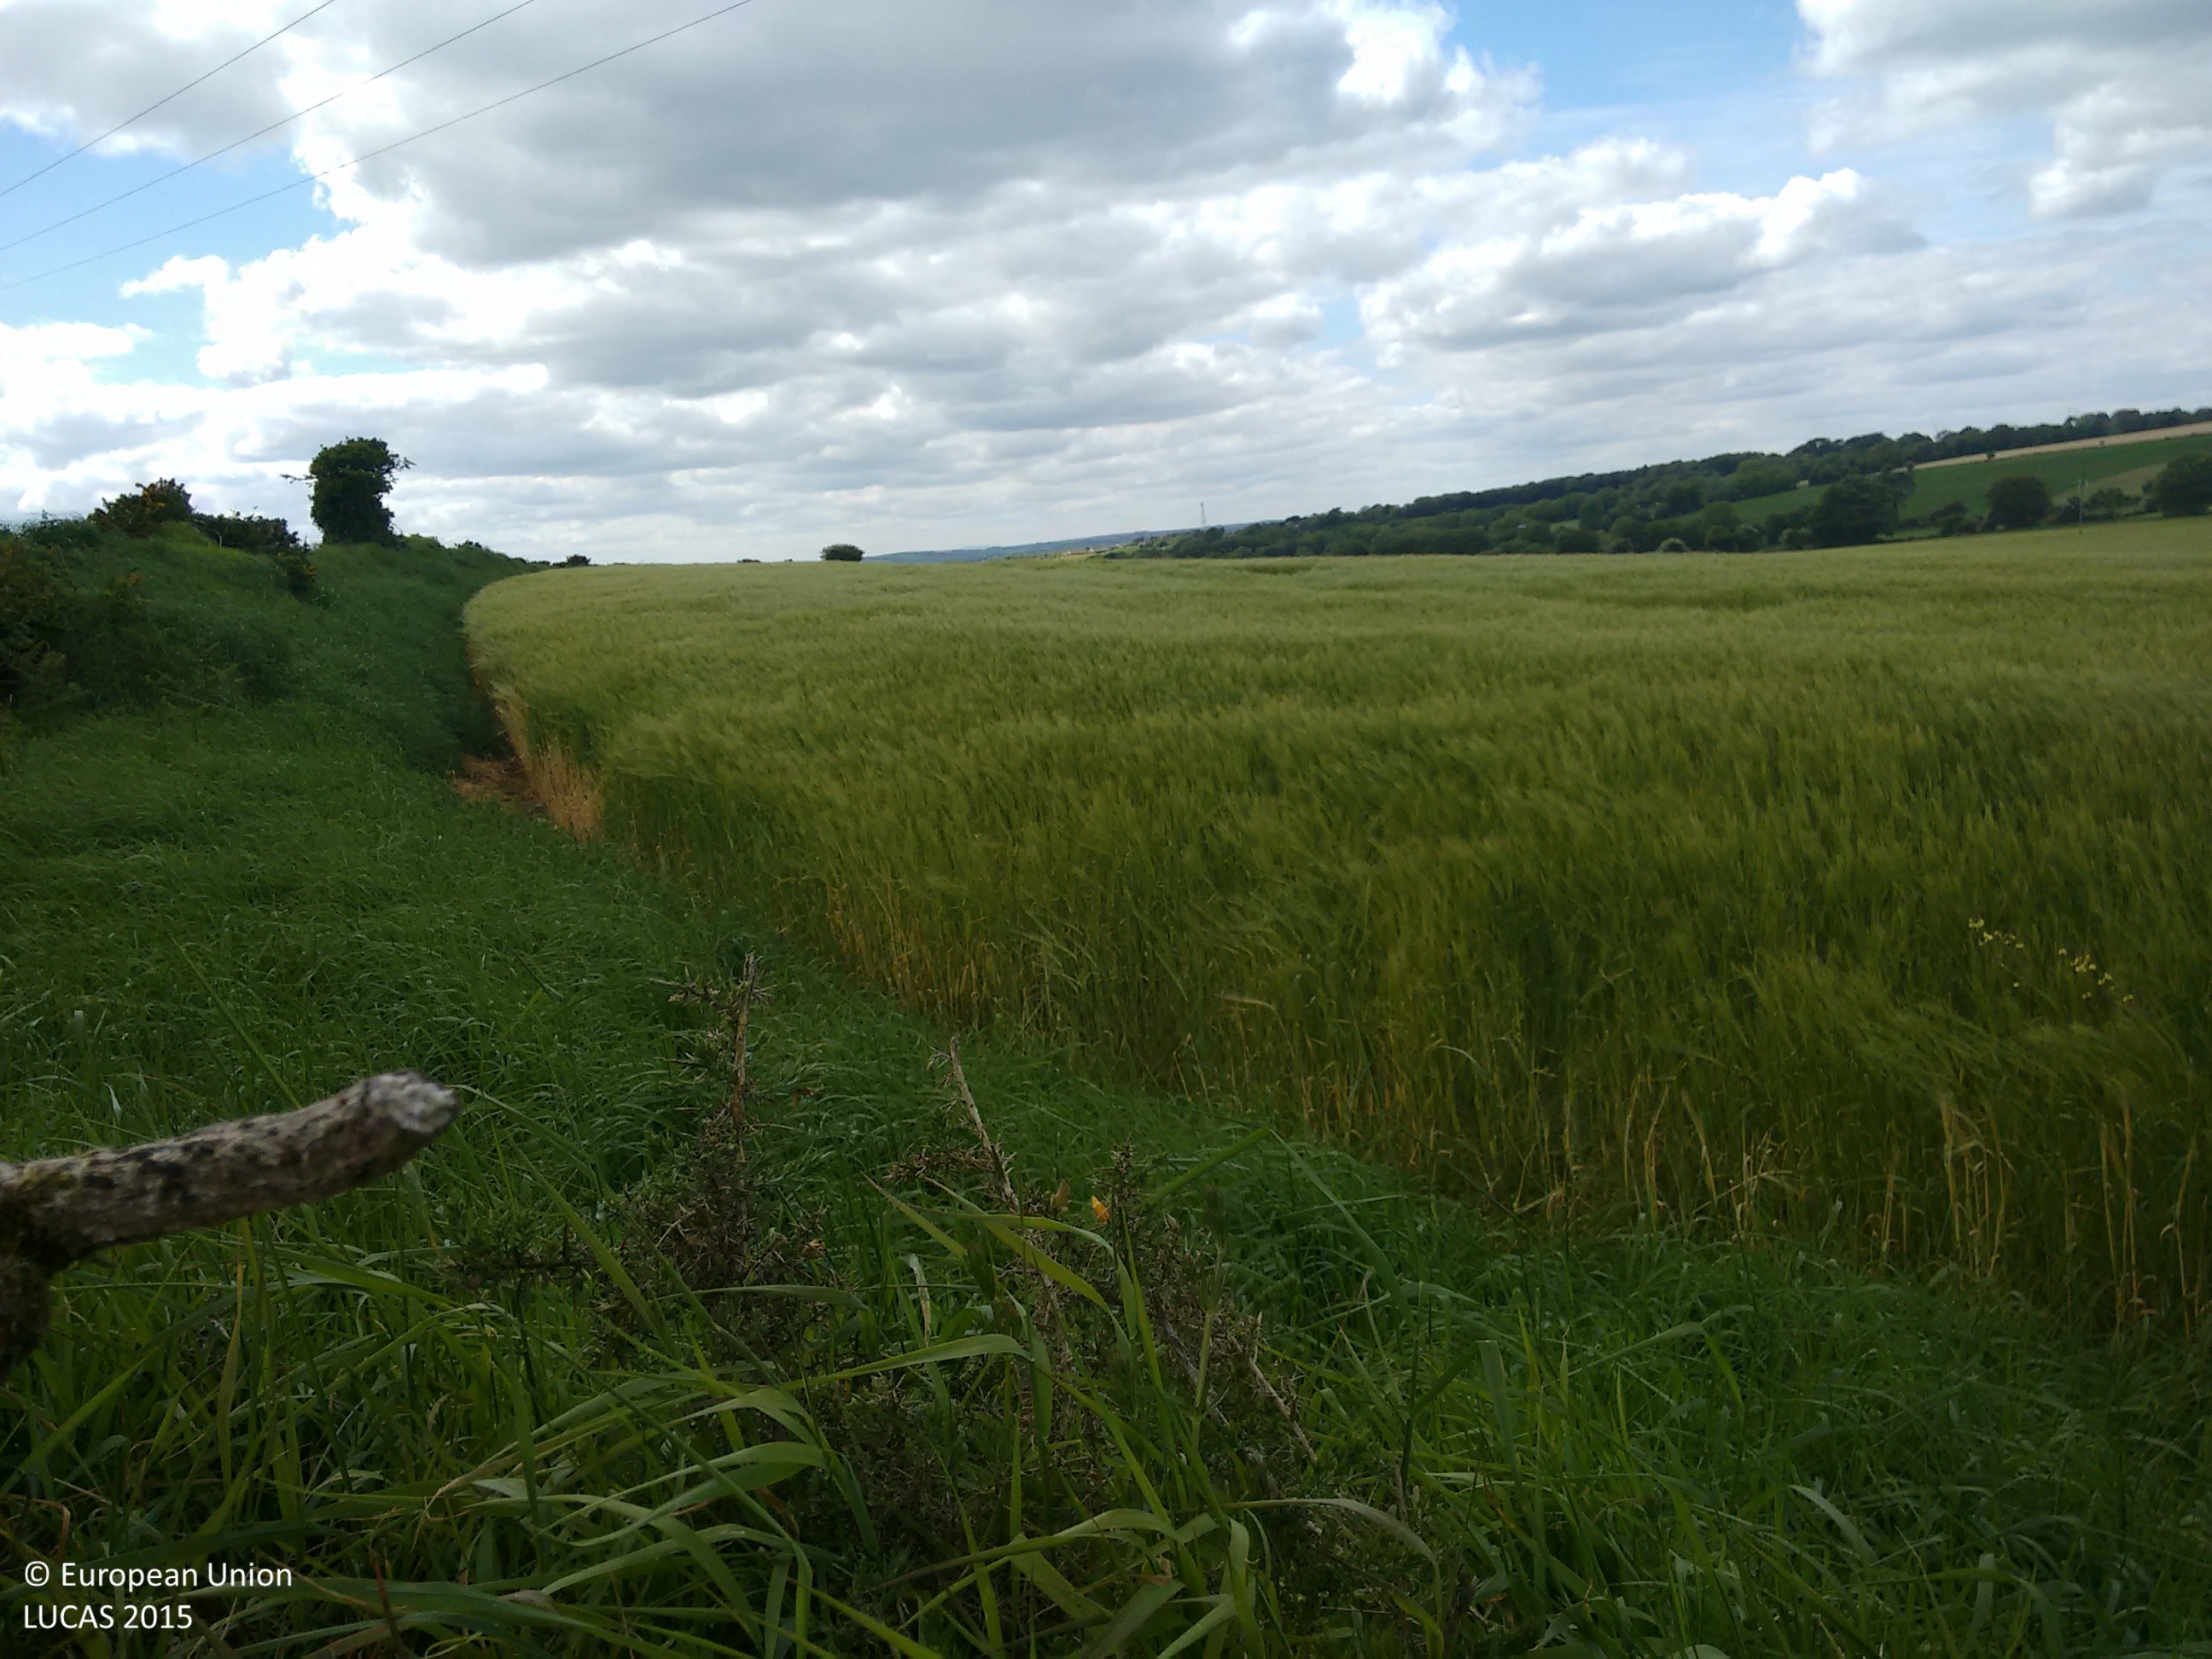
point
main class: Cropland
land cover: Barley
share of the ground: > 75 %
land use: Agriculture (excluding fallow land and kitchen gardens)
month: June
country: IE
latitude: 51.9440
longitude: -8.1174
